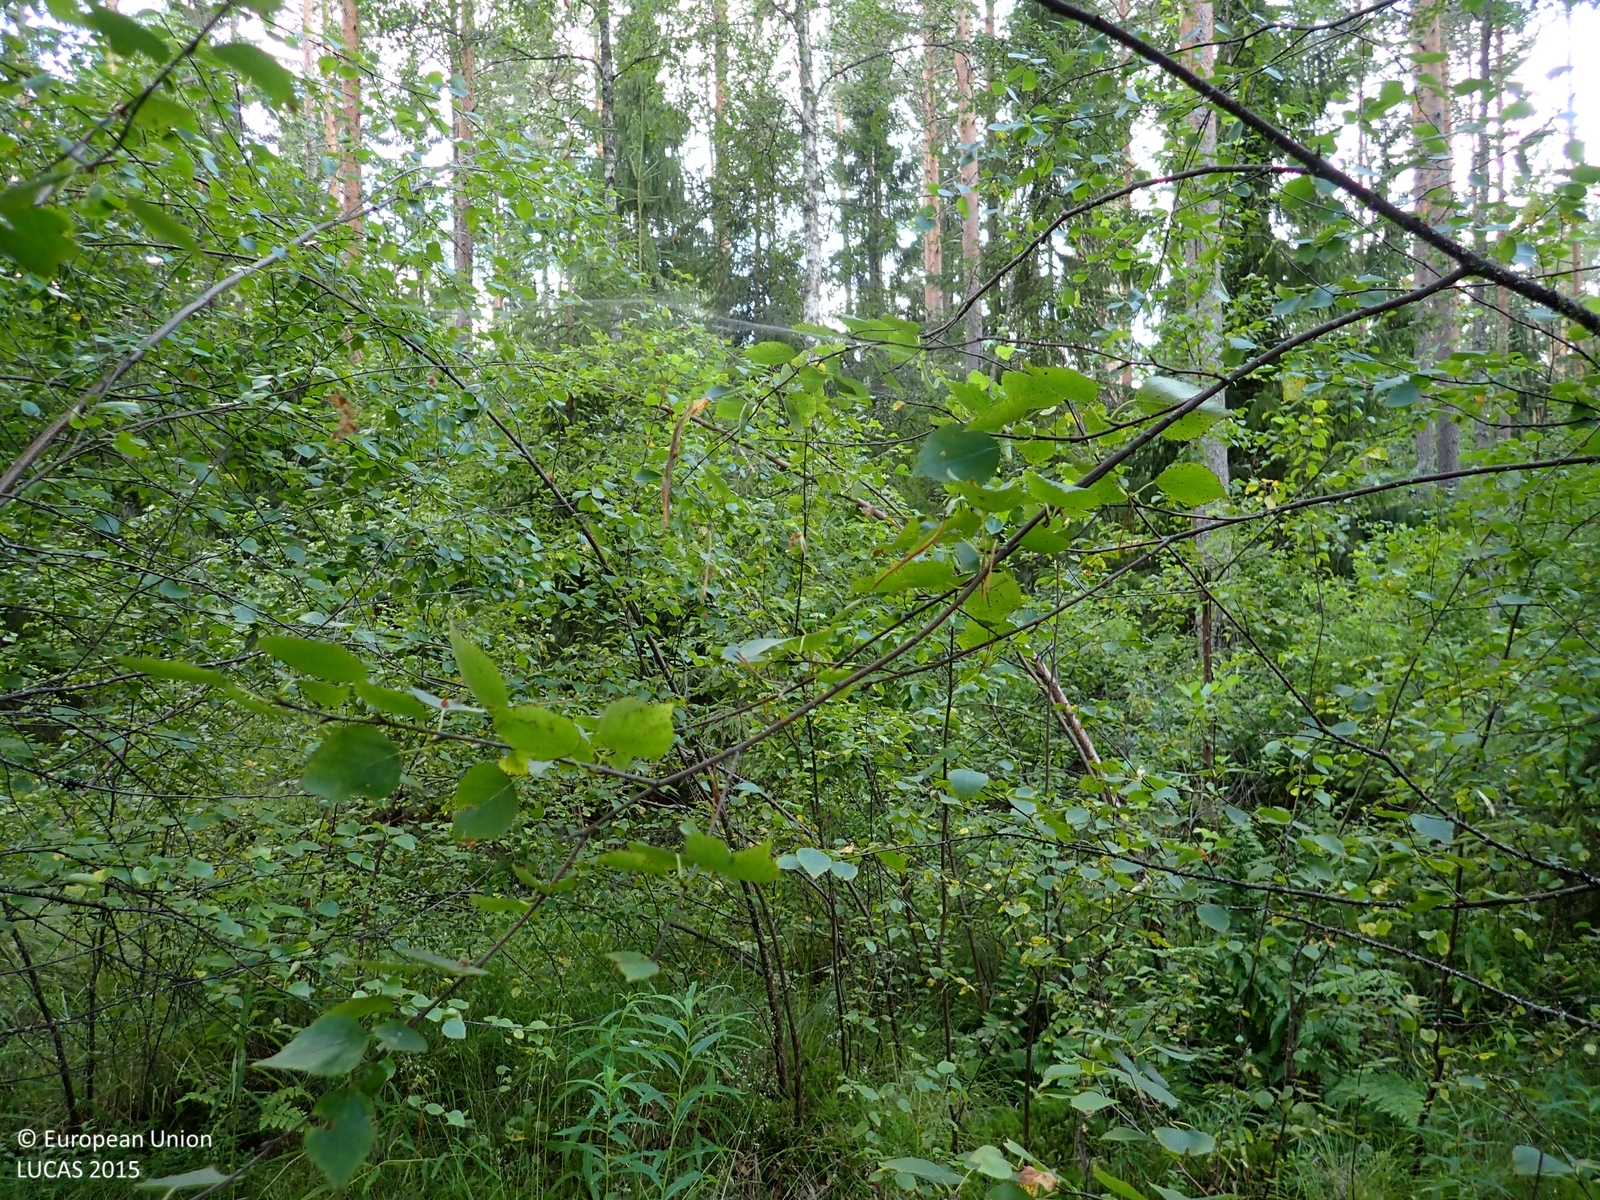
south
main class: Woodland
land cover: Pine dominated mixed woodland
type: boreal forest
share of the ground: > 75 %
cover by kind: coniferous forest trees 60 %, broadleaved forest trees 20 %, shrubs 15 %, herbaceous plants 5 %
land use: Forestry
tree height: > 5 m
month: August
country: FI
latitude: 62.7513
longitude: 22.0091
